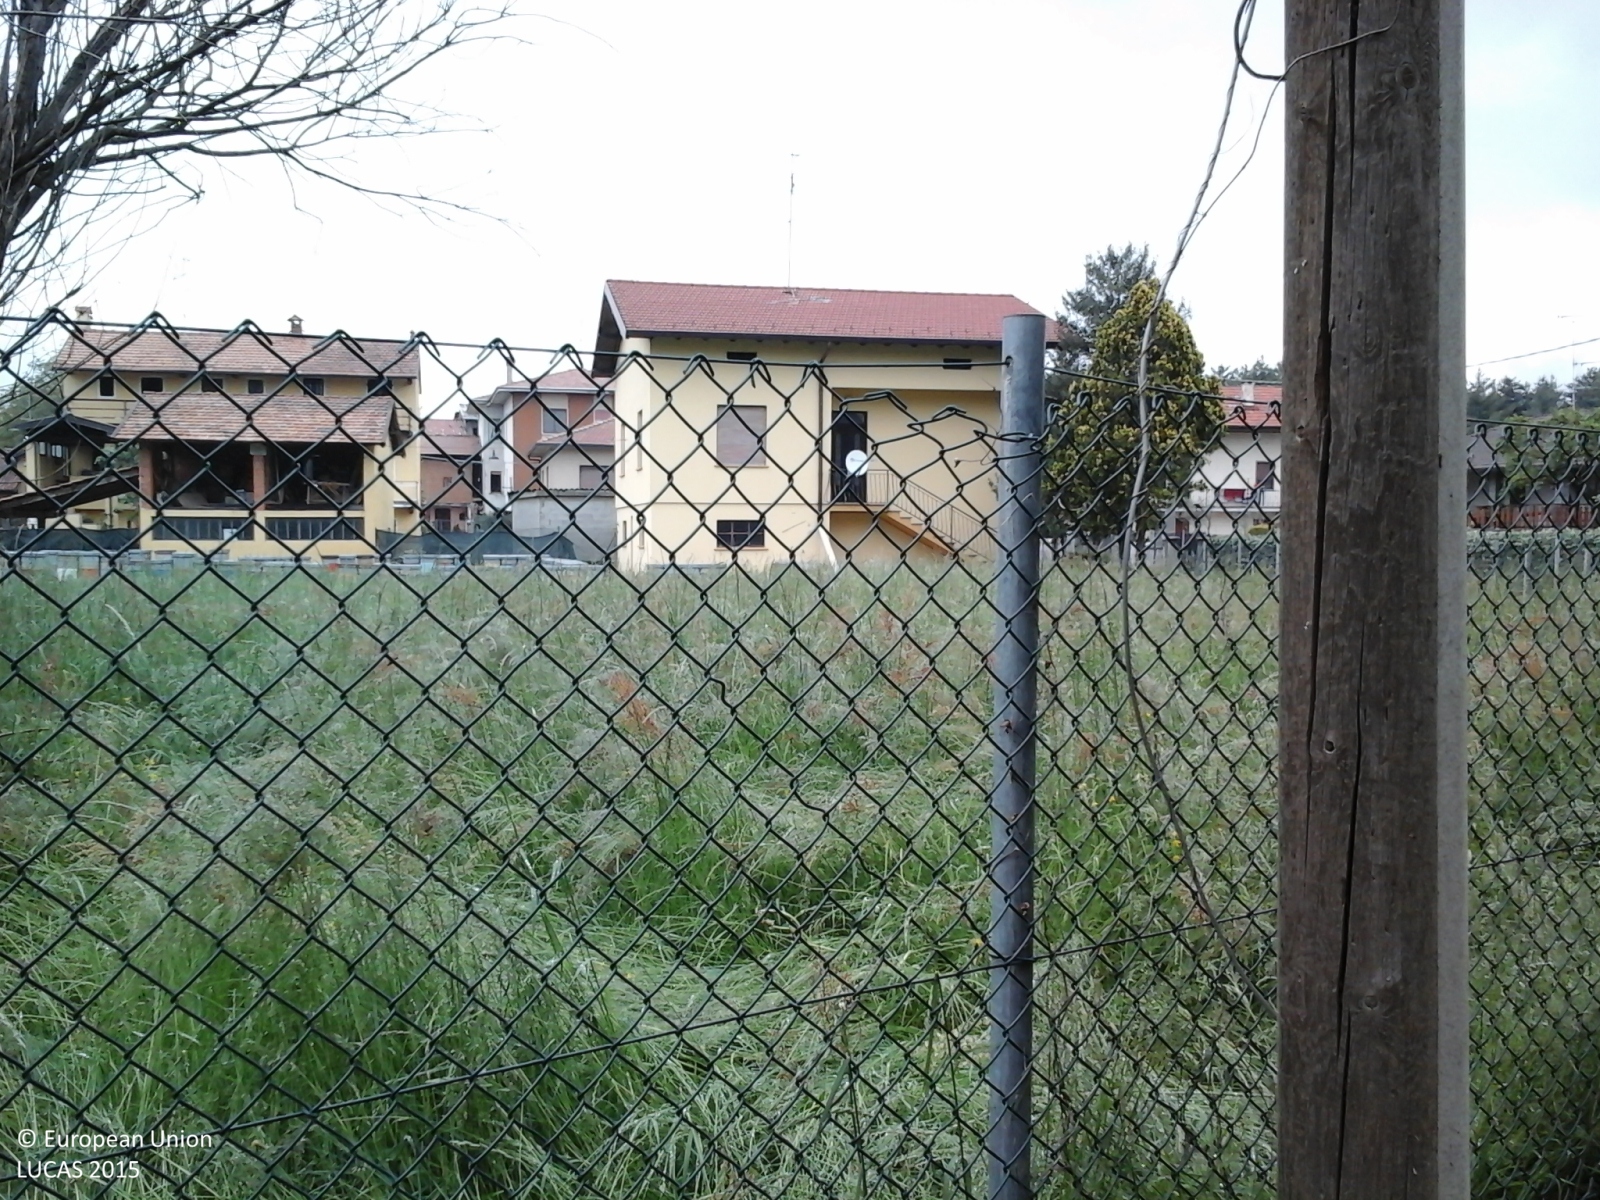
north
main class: Grassland
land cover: Grassland with sparse tree/shrub cover
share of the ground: > 75 %
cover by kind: herbaceous plants 95 %, broadleaved forest trees 5 %
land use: Residential
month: May
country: IT
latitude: 45.6574
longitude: 8.6034
